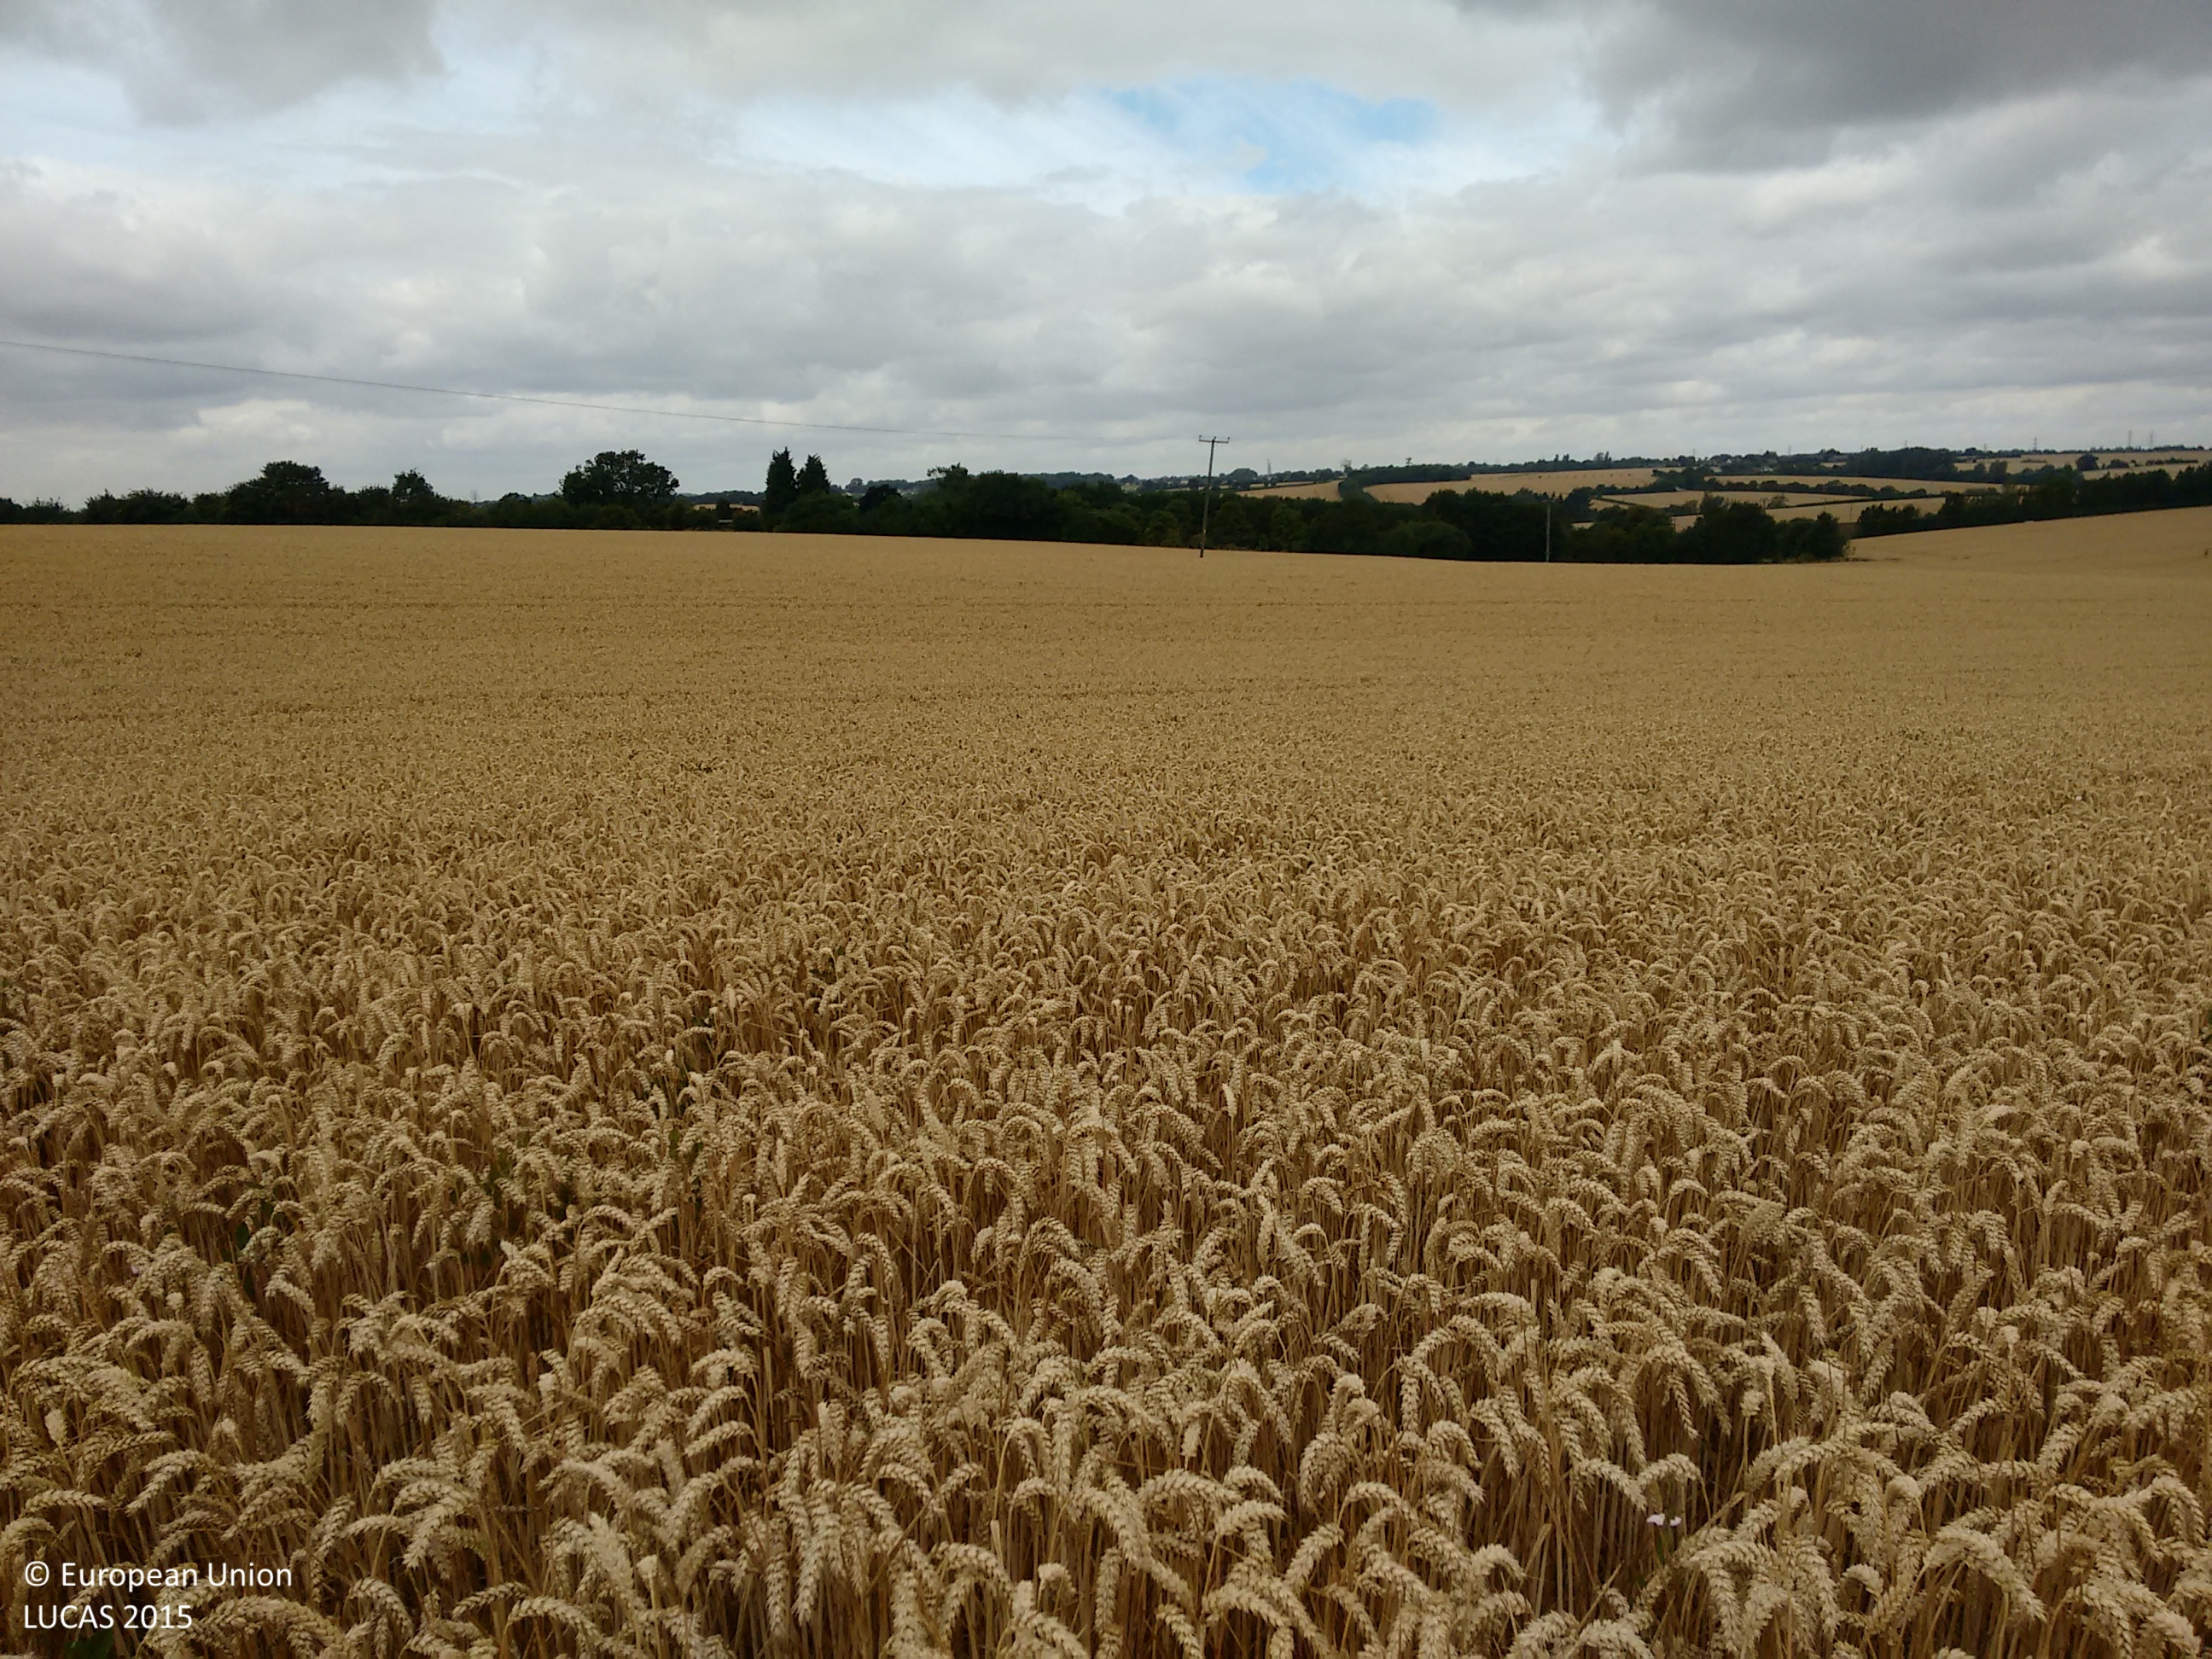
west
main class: Cropland
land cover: Common wheat
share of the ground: > 75 %
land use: Agriculture (excluding fallow land and kitchen gardens)
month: August
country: GB
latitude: 51.9476
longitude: 0.3541
